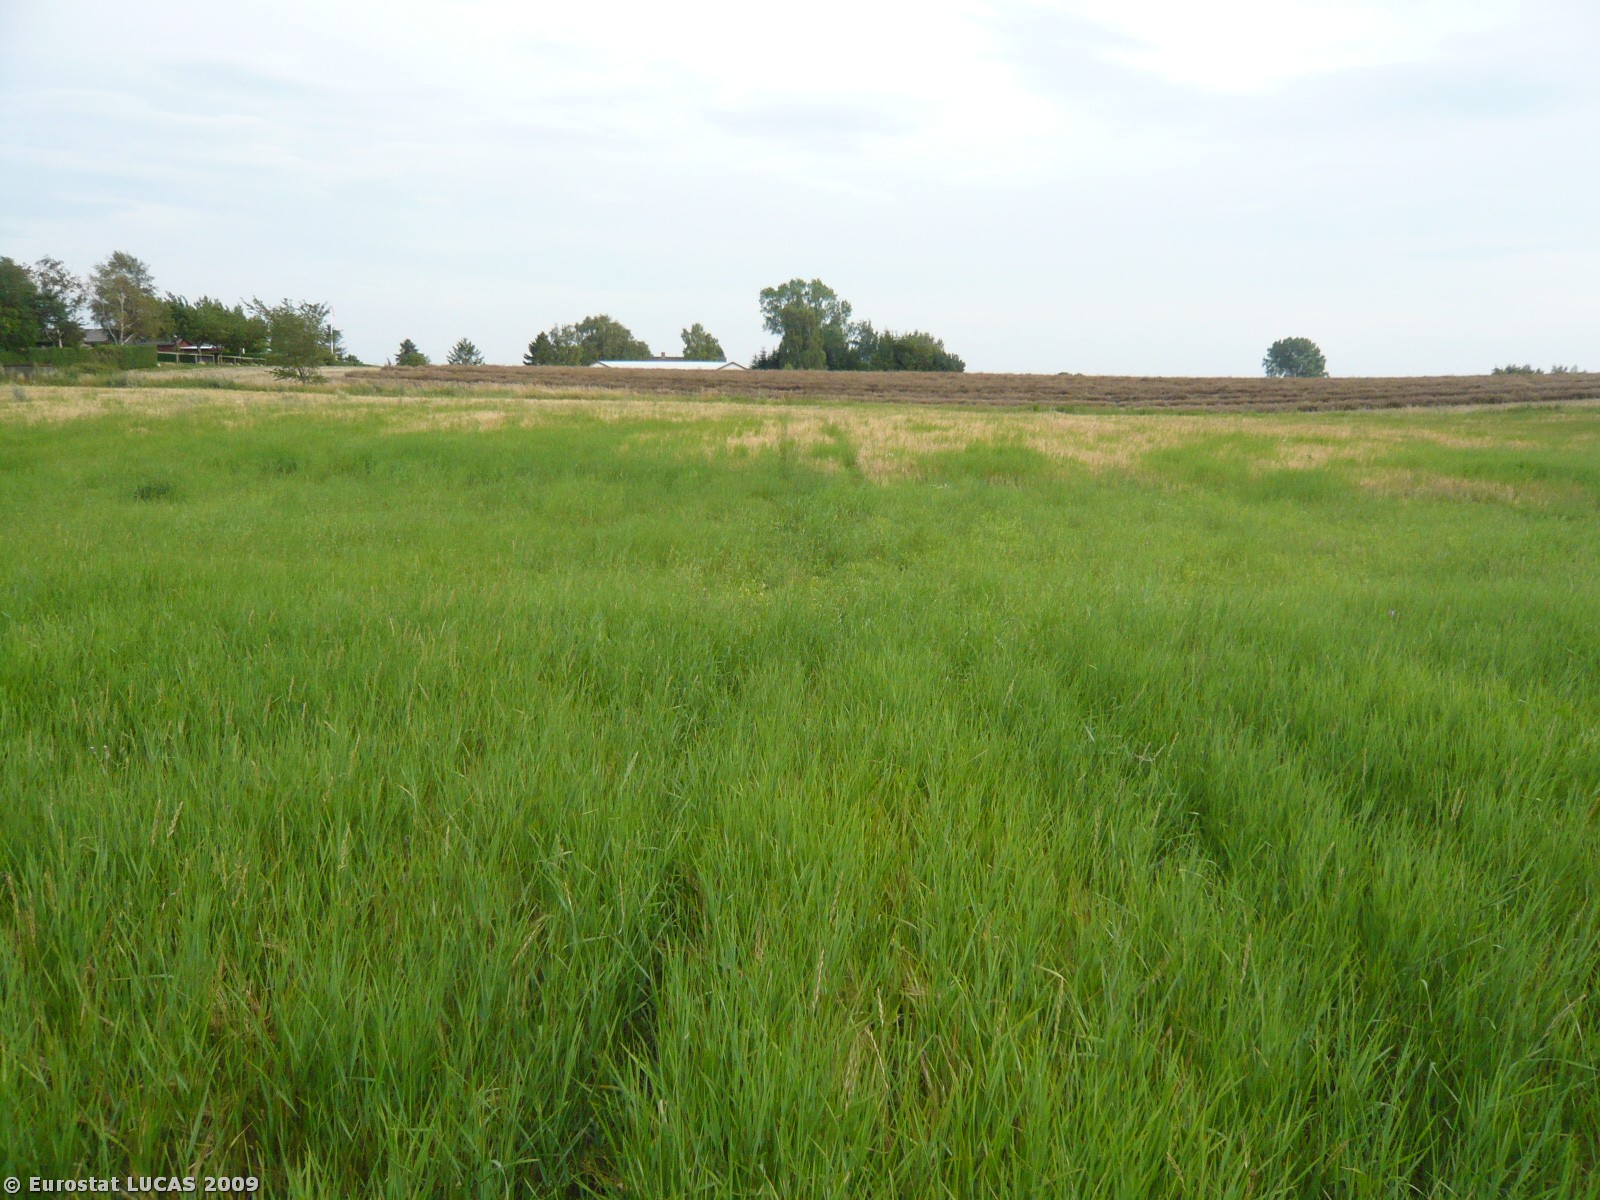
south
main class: Grassland
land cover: Spontaneously vegetated surfaces
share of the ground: > 75 %
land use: Fallow land
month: July
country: DK
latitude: 55.9358
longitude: 12.1591
